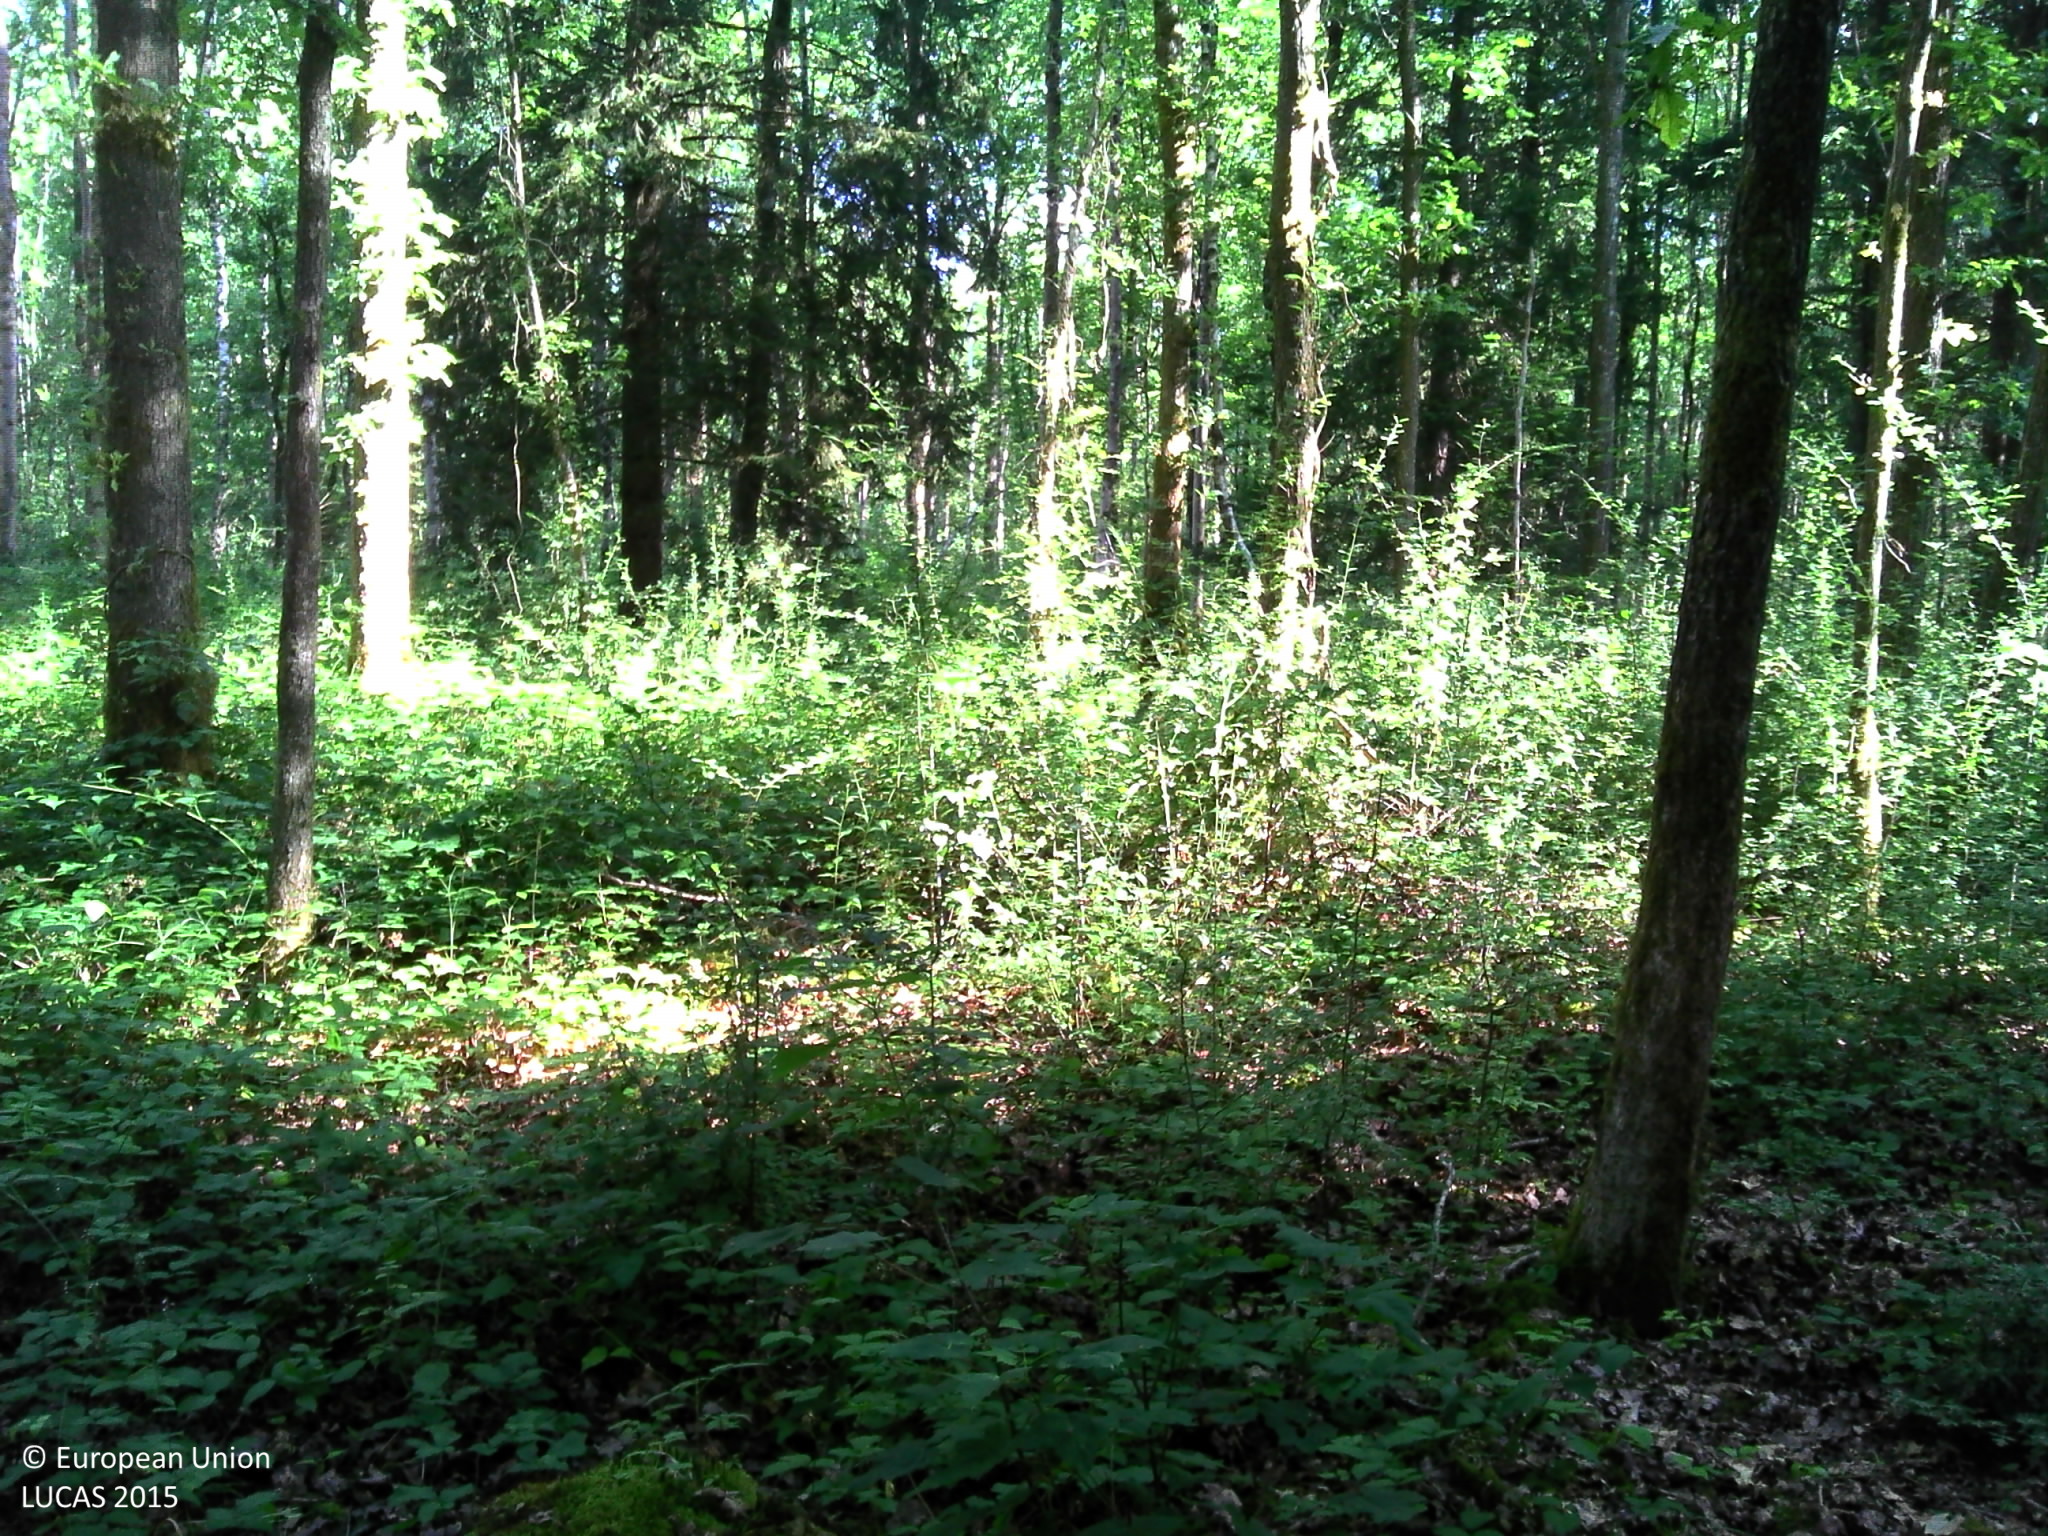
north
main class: Woodland
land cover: Broadleaved woodland
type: acidophilous oak and oak-birch forest
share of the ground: > 75 %
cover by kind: broadleaved forest trees 90 %, coniferous forest trees 10 %
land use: Forestry
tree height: > 5 m
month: July
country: BE
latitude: 49.6831
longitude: 5.5495
